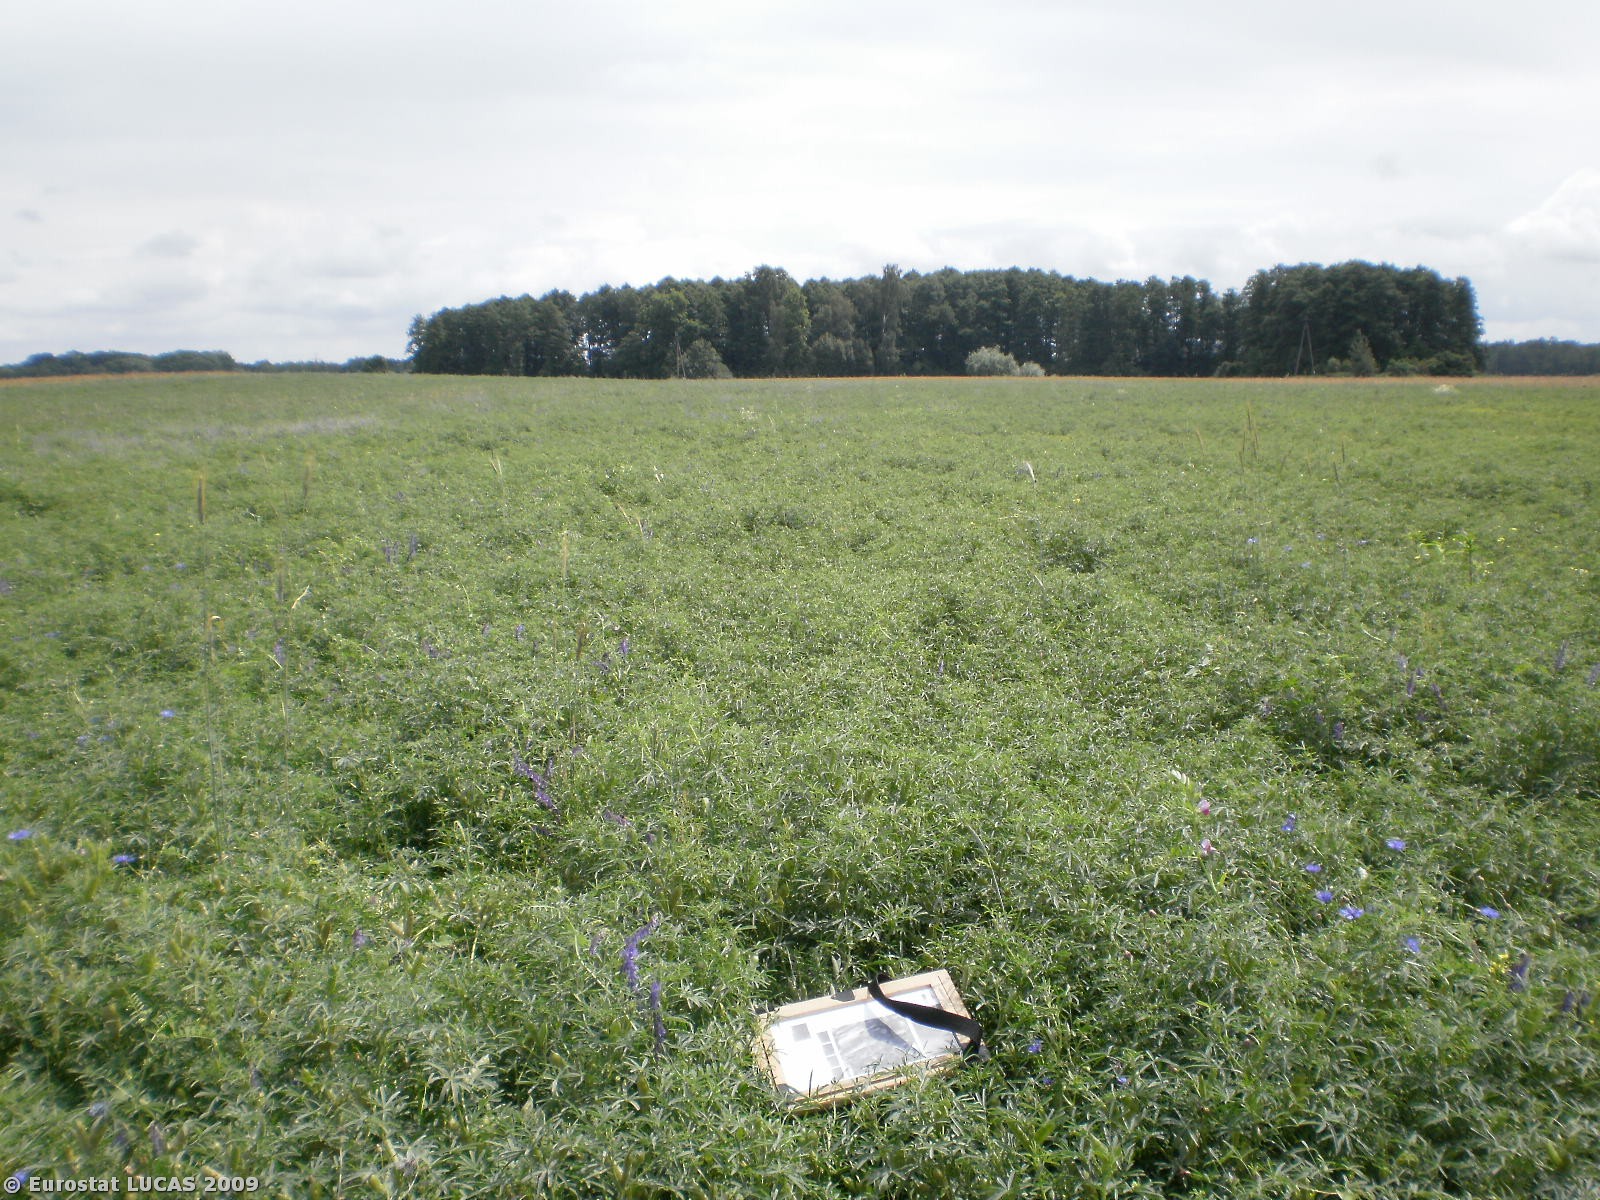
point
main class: Cropland
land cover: Dry pulses
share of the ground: > 75 %
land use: Agriculture (excluding fallow land and kitchen gardens)
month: July
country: PL
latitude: 52.6153
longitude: 20.9284
